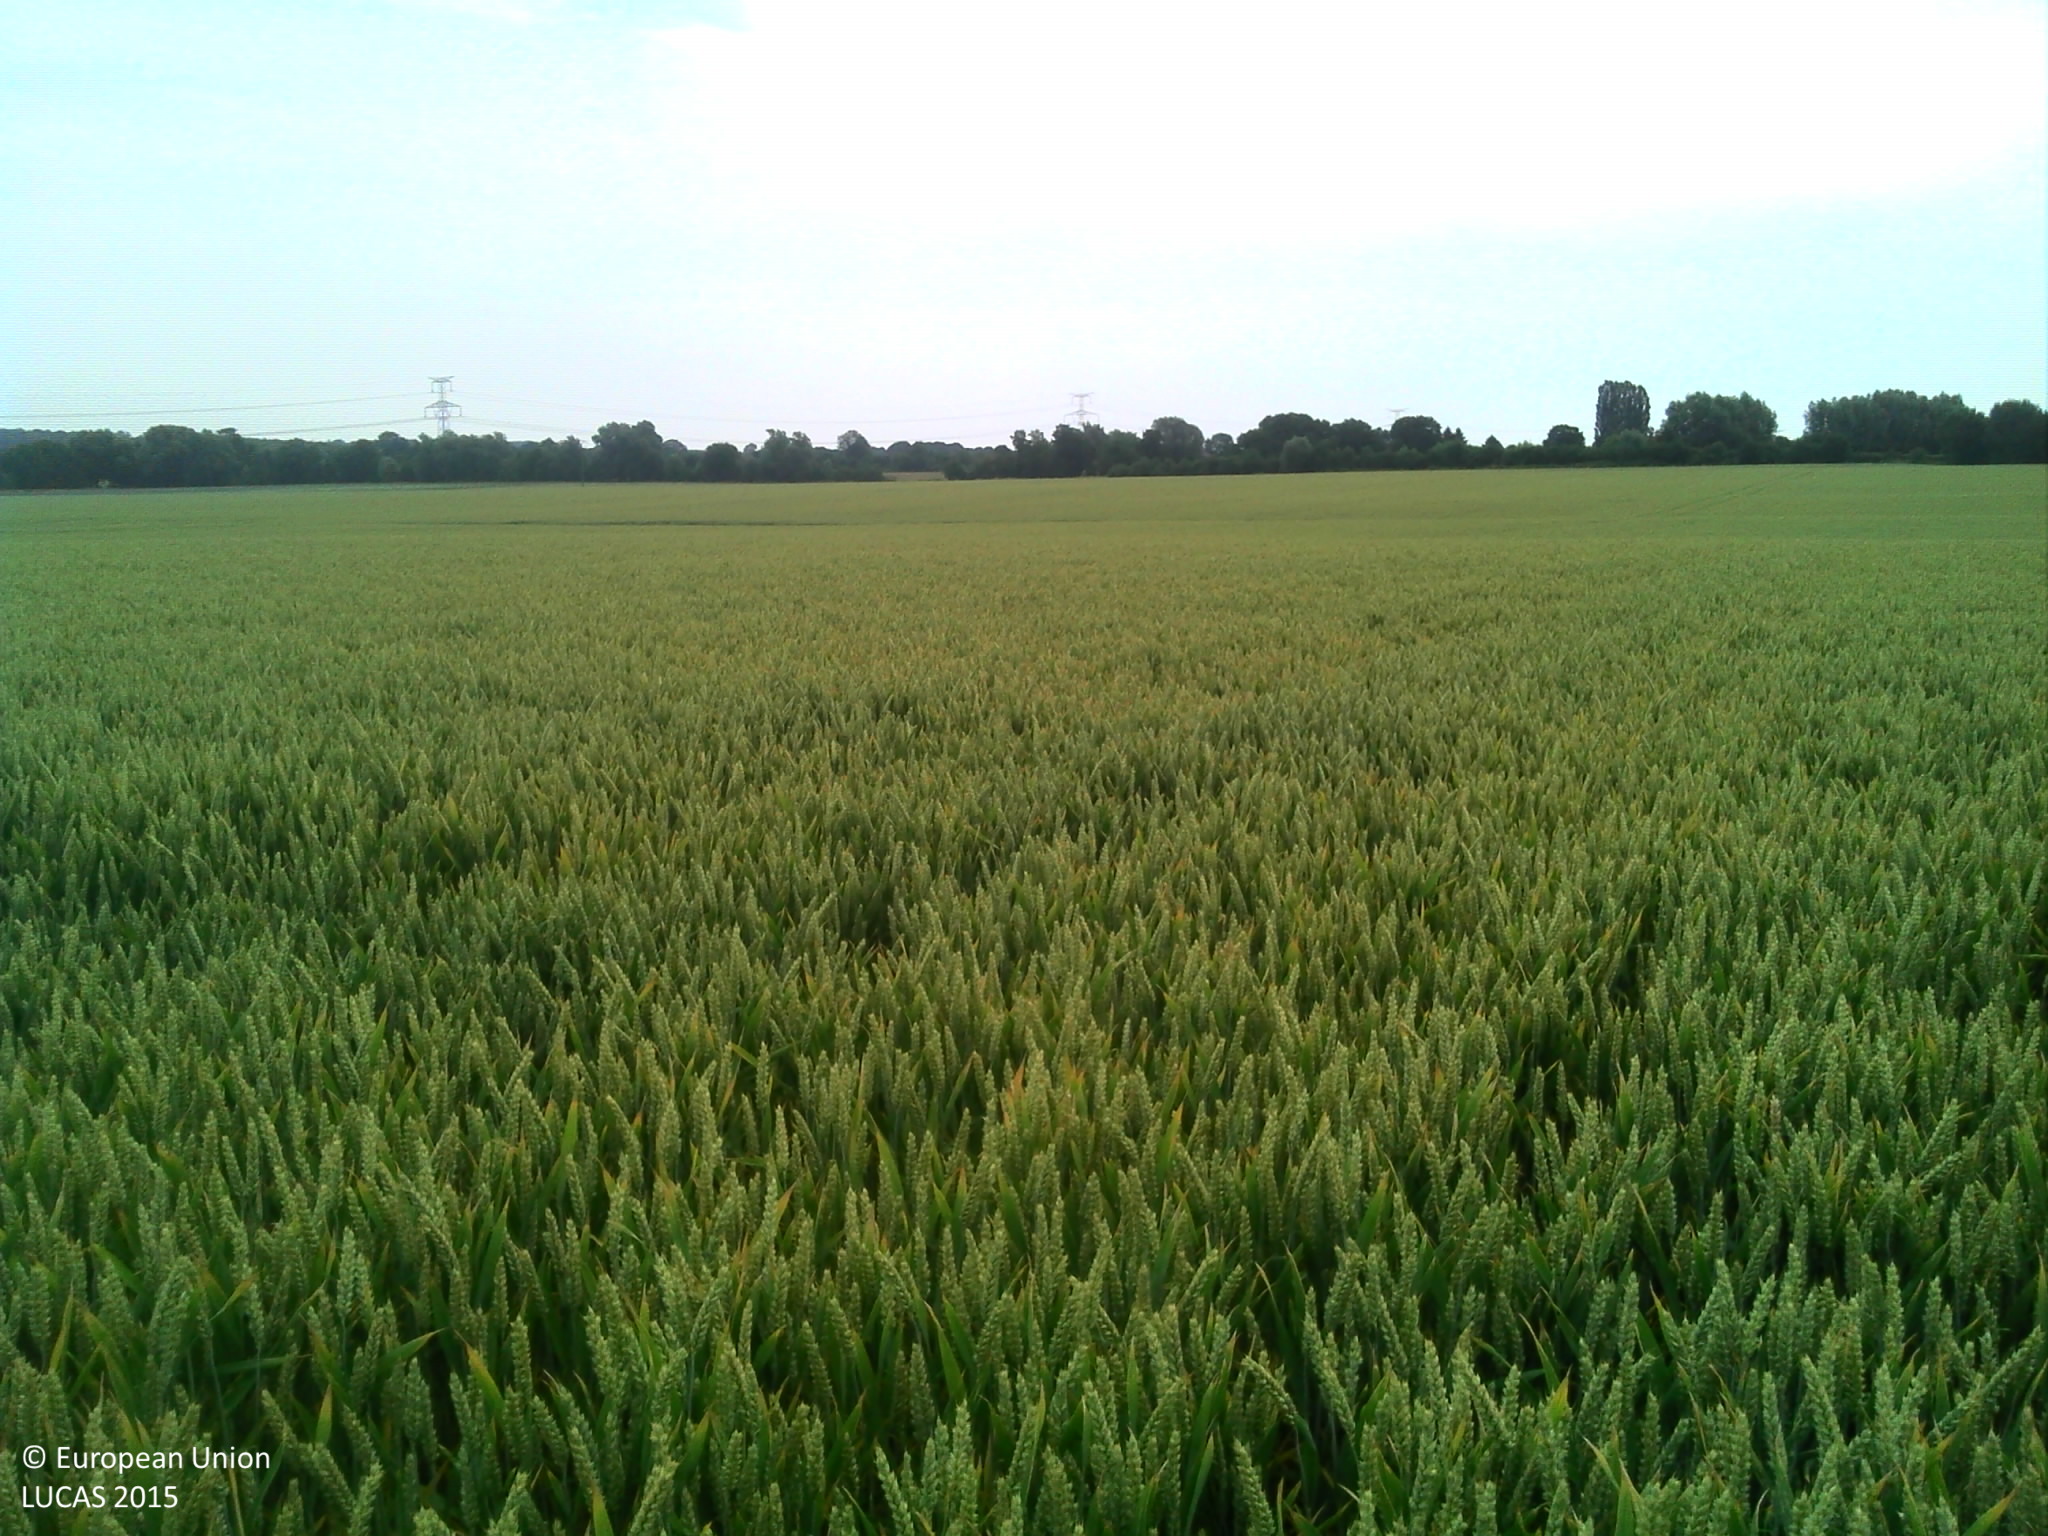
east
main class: Cropland
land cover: Common wheat
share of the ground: > 75 %
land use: Agriculture (excluding fallow land and kitchen gardens)
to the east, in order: Common wheat
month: July
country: FR
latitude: 49.9906
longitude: 3.6746
